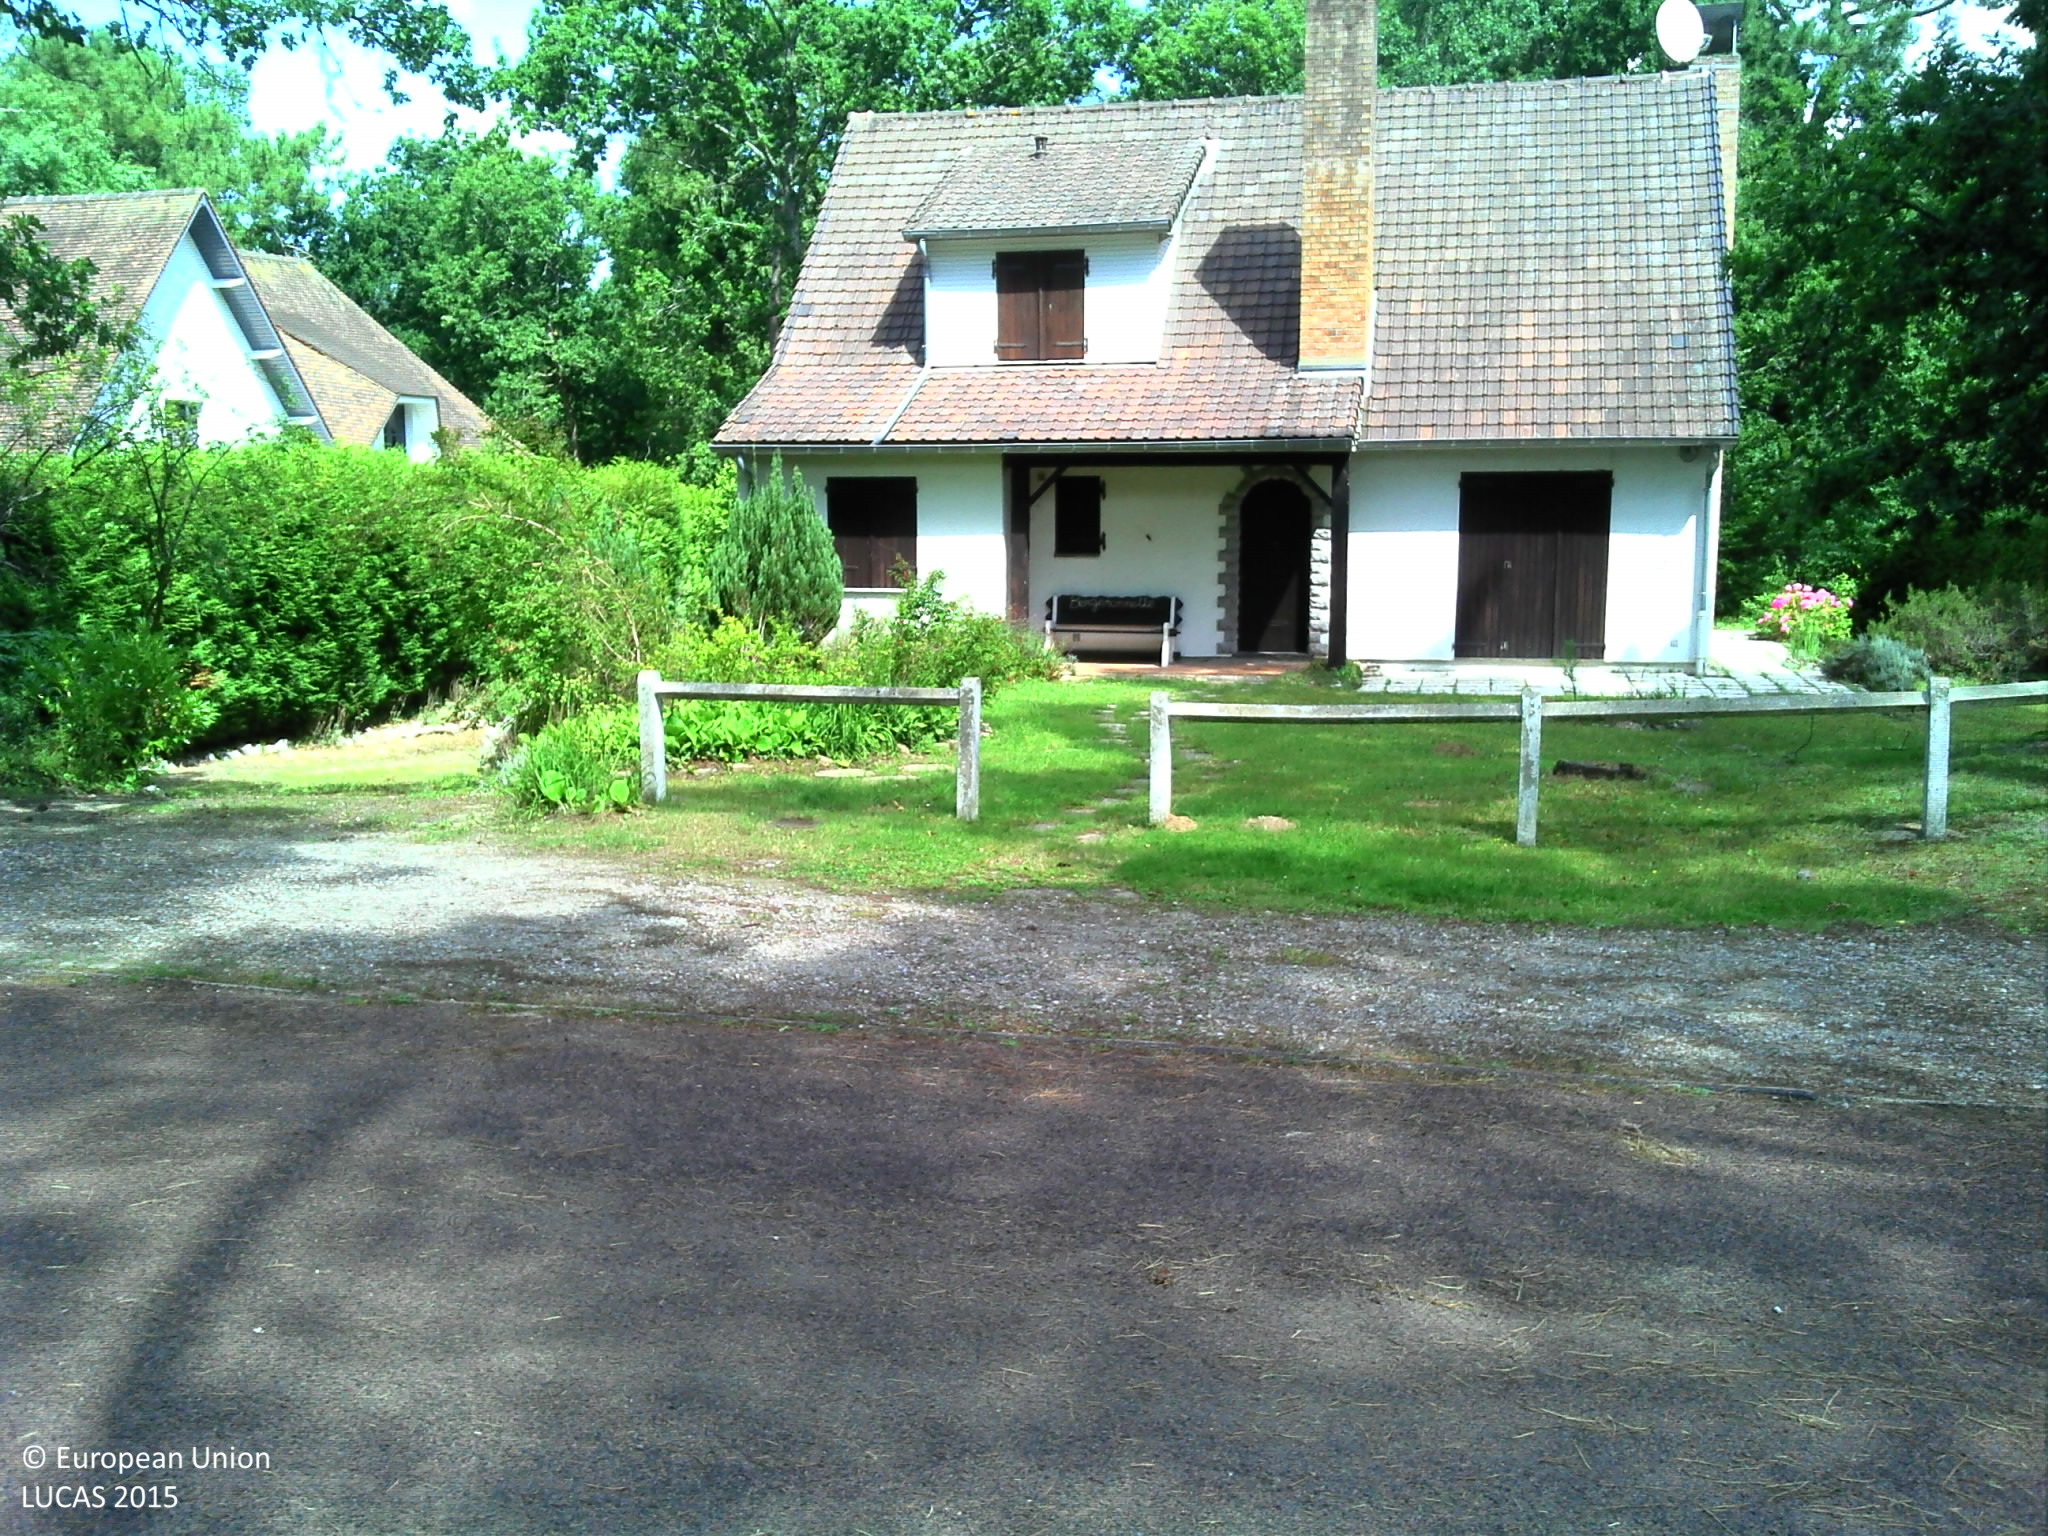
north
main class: Woodland
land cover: Pine dominated coniferous woodland
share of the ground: 50 - 75 %
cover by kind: herbaceous plants 60 %, coniferous forest trees 40 %
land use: Residential
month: July
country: FR
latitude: 50.5081
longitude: 1.6199
